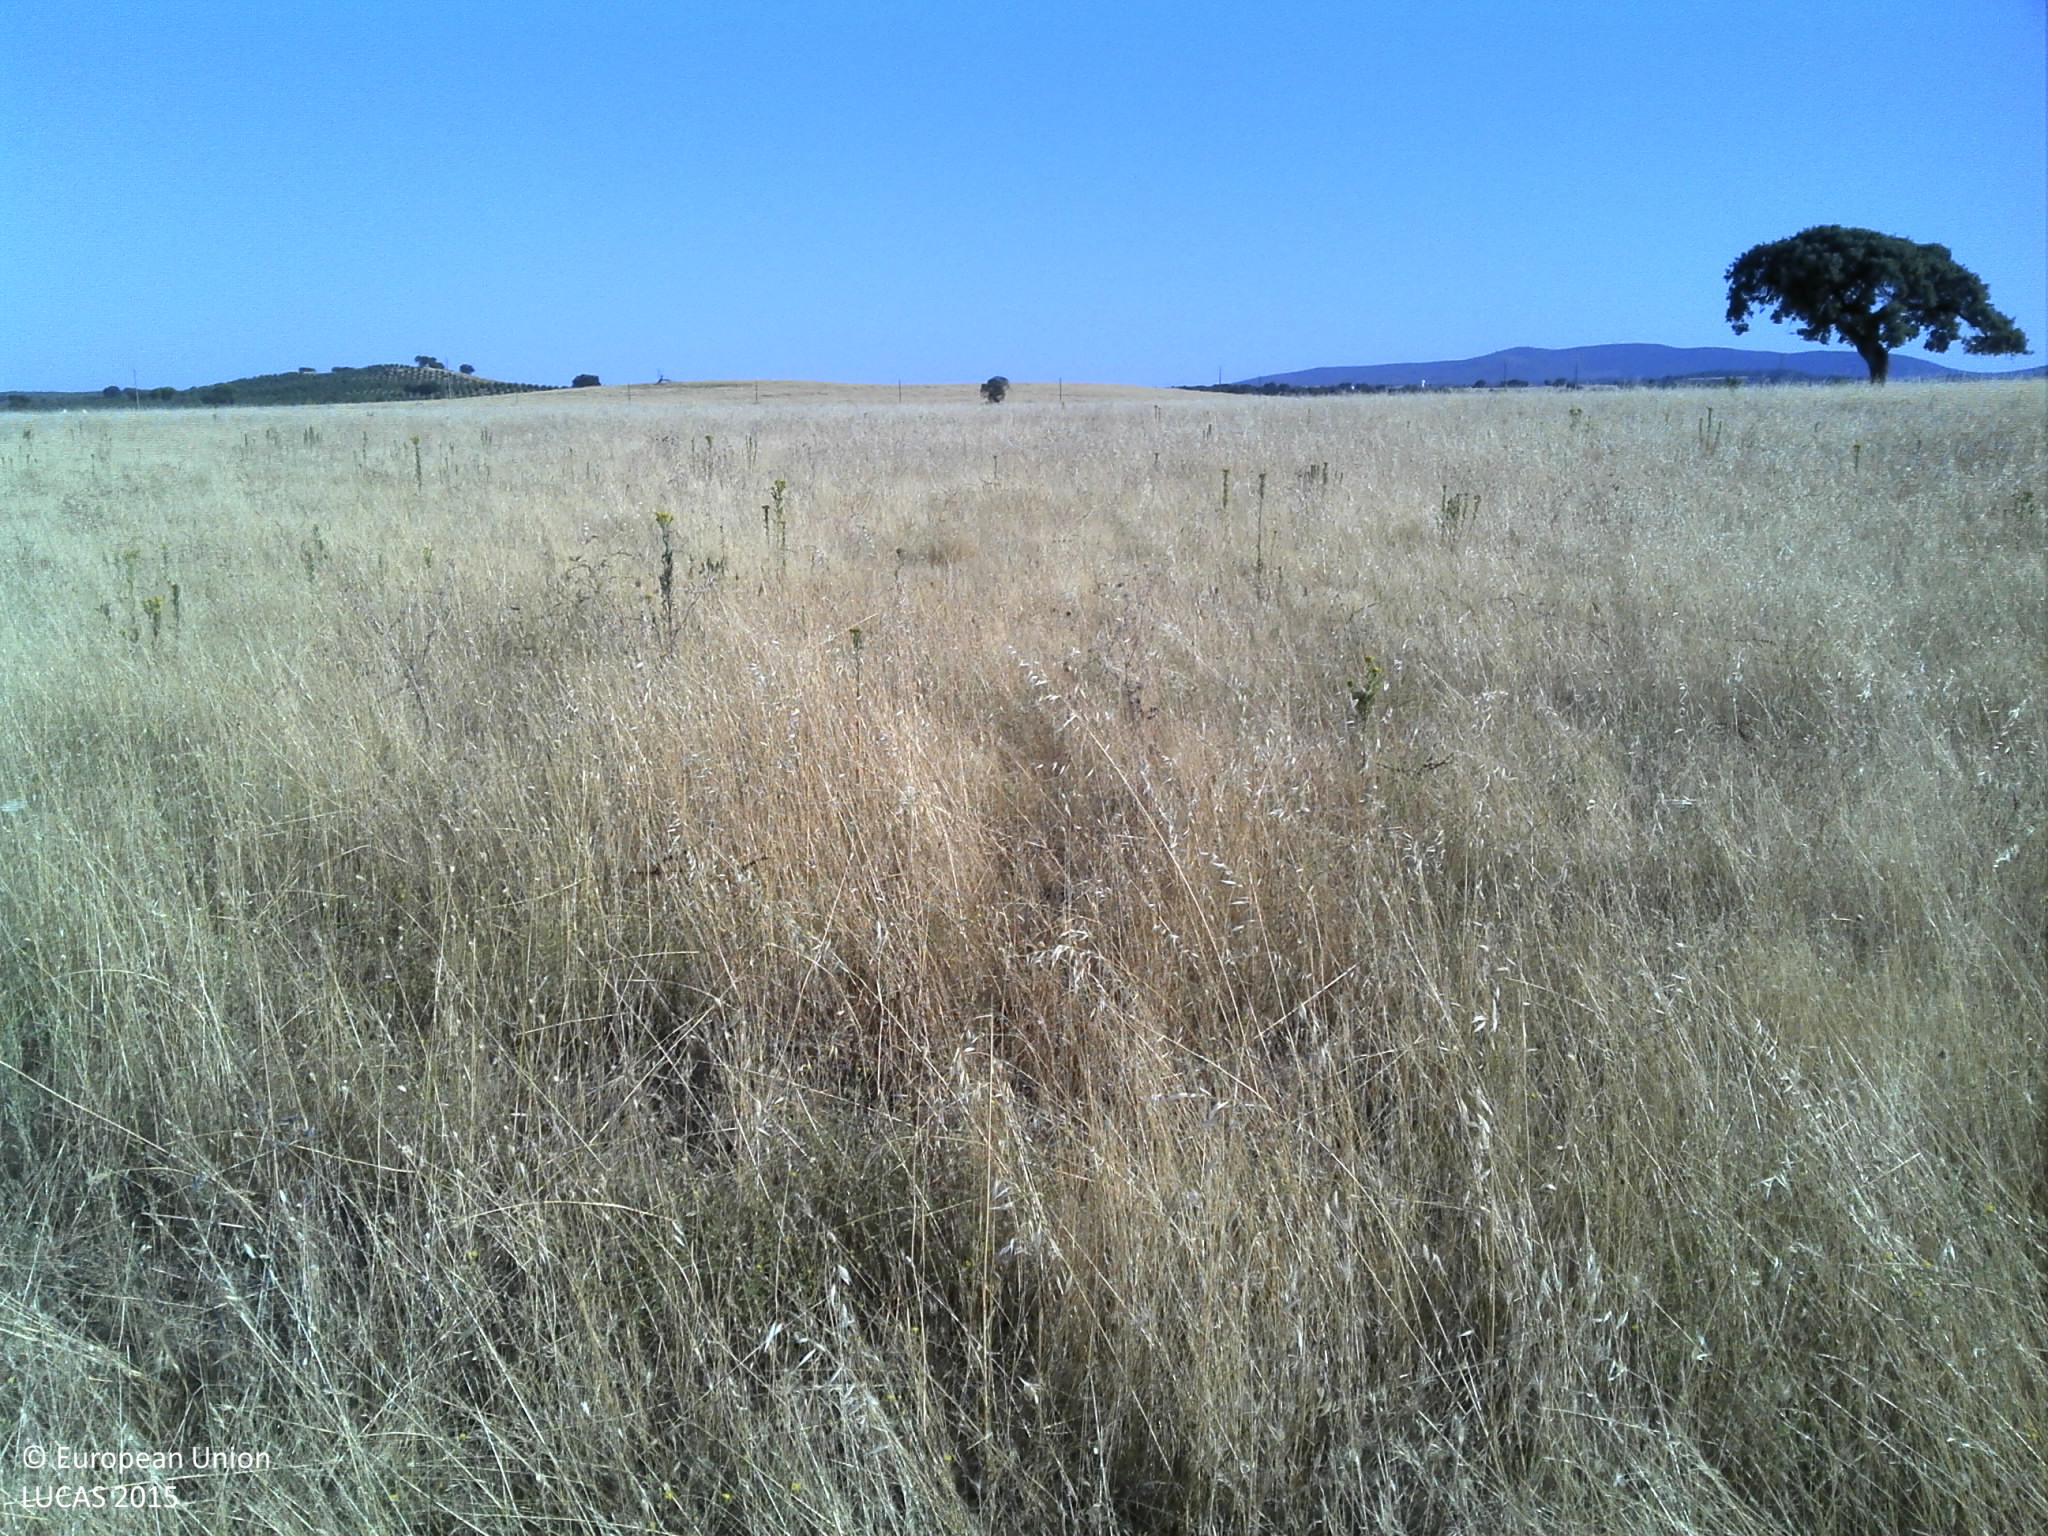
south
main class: Grassland
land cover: Grassland without tree/shrub cover
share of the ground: > 75 %
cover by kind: herbaceous plants 100 %
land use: Agriculture (excluding fallow land and kitchen gardens)
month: June
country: PT
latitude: 38.0600
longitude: -7.2591
